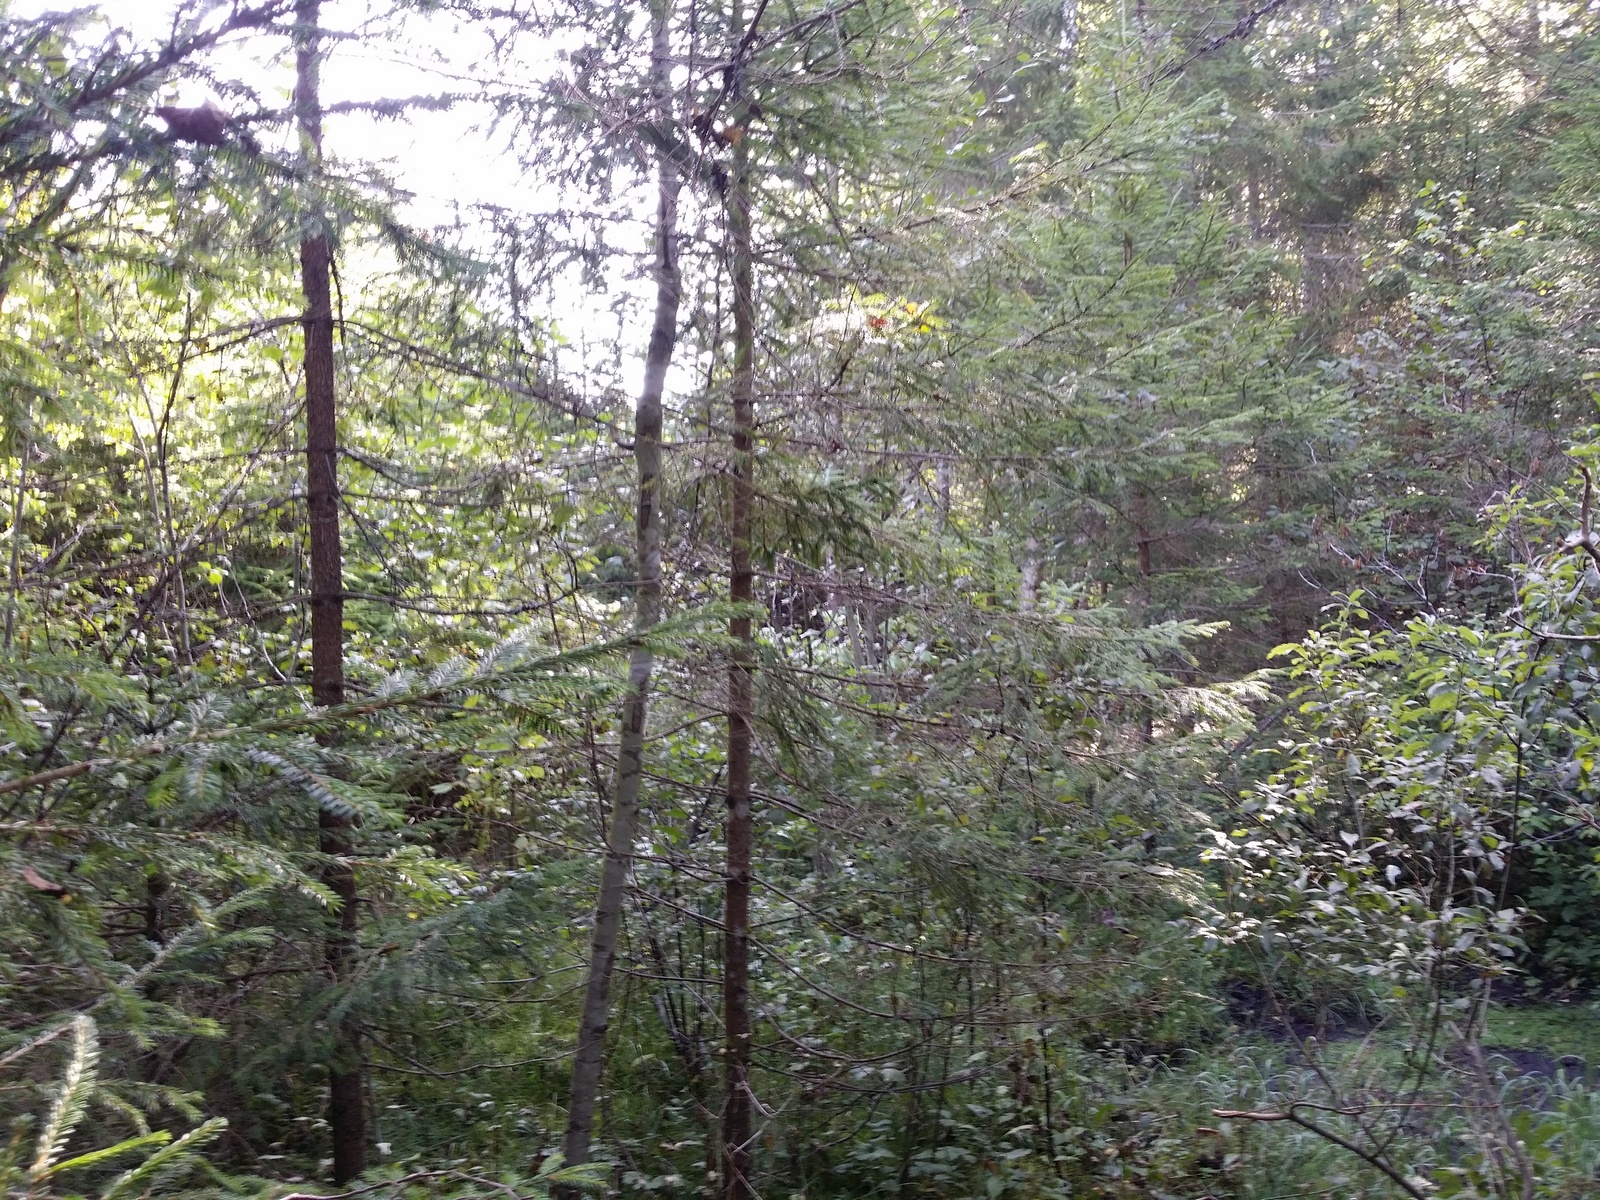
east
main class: Woodland
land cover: Spruce dominated mixed woodland
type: hemiboreal forest and nemoral coniferous forest and mixed broadleaved-coniferous forest
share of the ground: > 75 %
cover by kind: coniferous forest trees 50 %, broadleaved forest trees 35 %, shrubs 10 %, lichens and mosses 5 %
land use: Forestry
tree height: > 5 m
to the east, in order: Spruce dominated mixed woodland; Other mixed woodland; Broadleaved woodland; Tracks; Broadleaved woodland; Grassland with sparse tree/shrub cover; Fences; Spontaneously vegetated surfaces
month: August
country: LV
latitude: 57.4369
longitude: 26.8623
